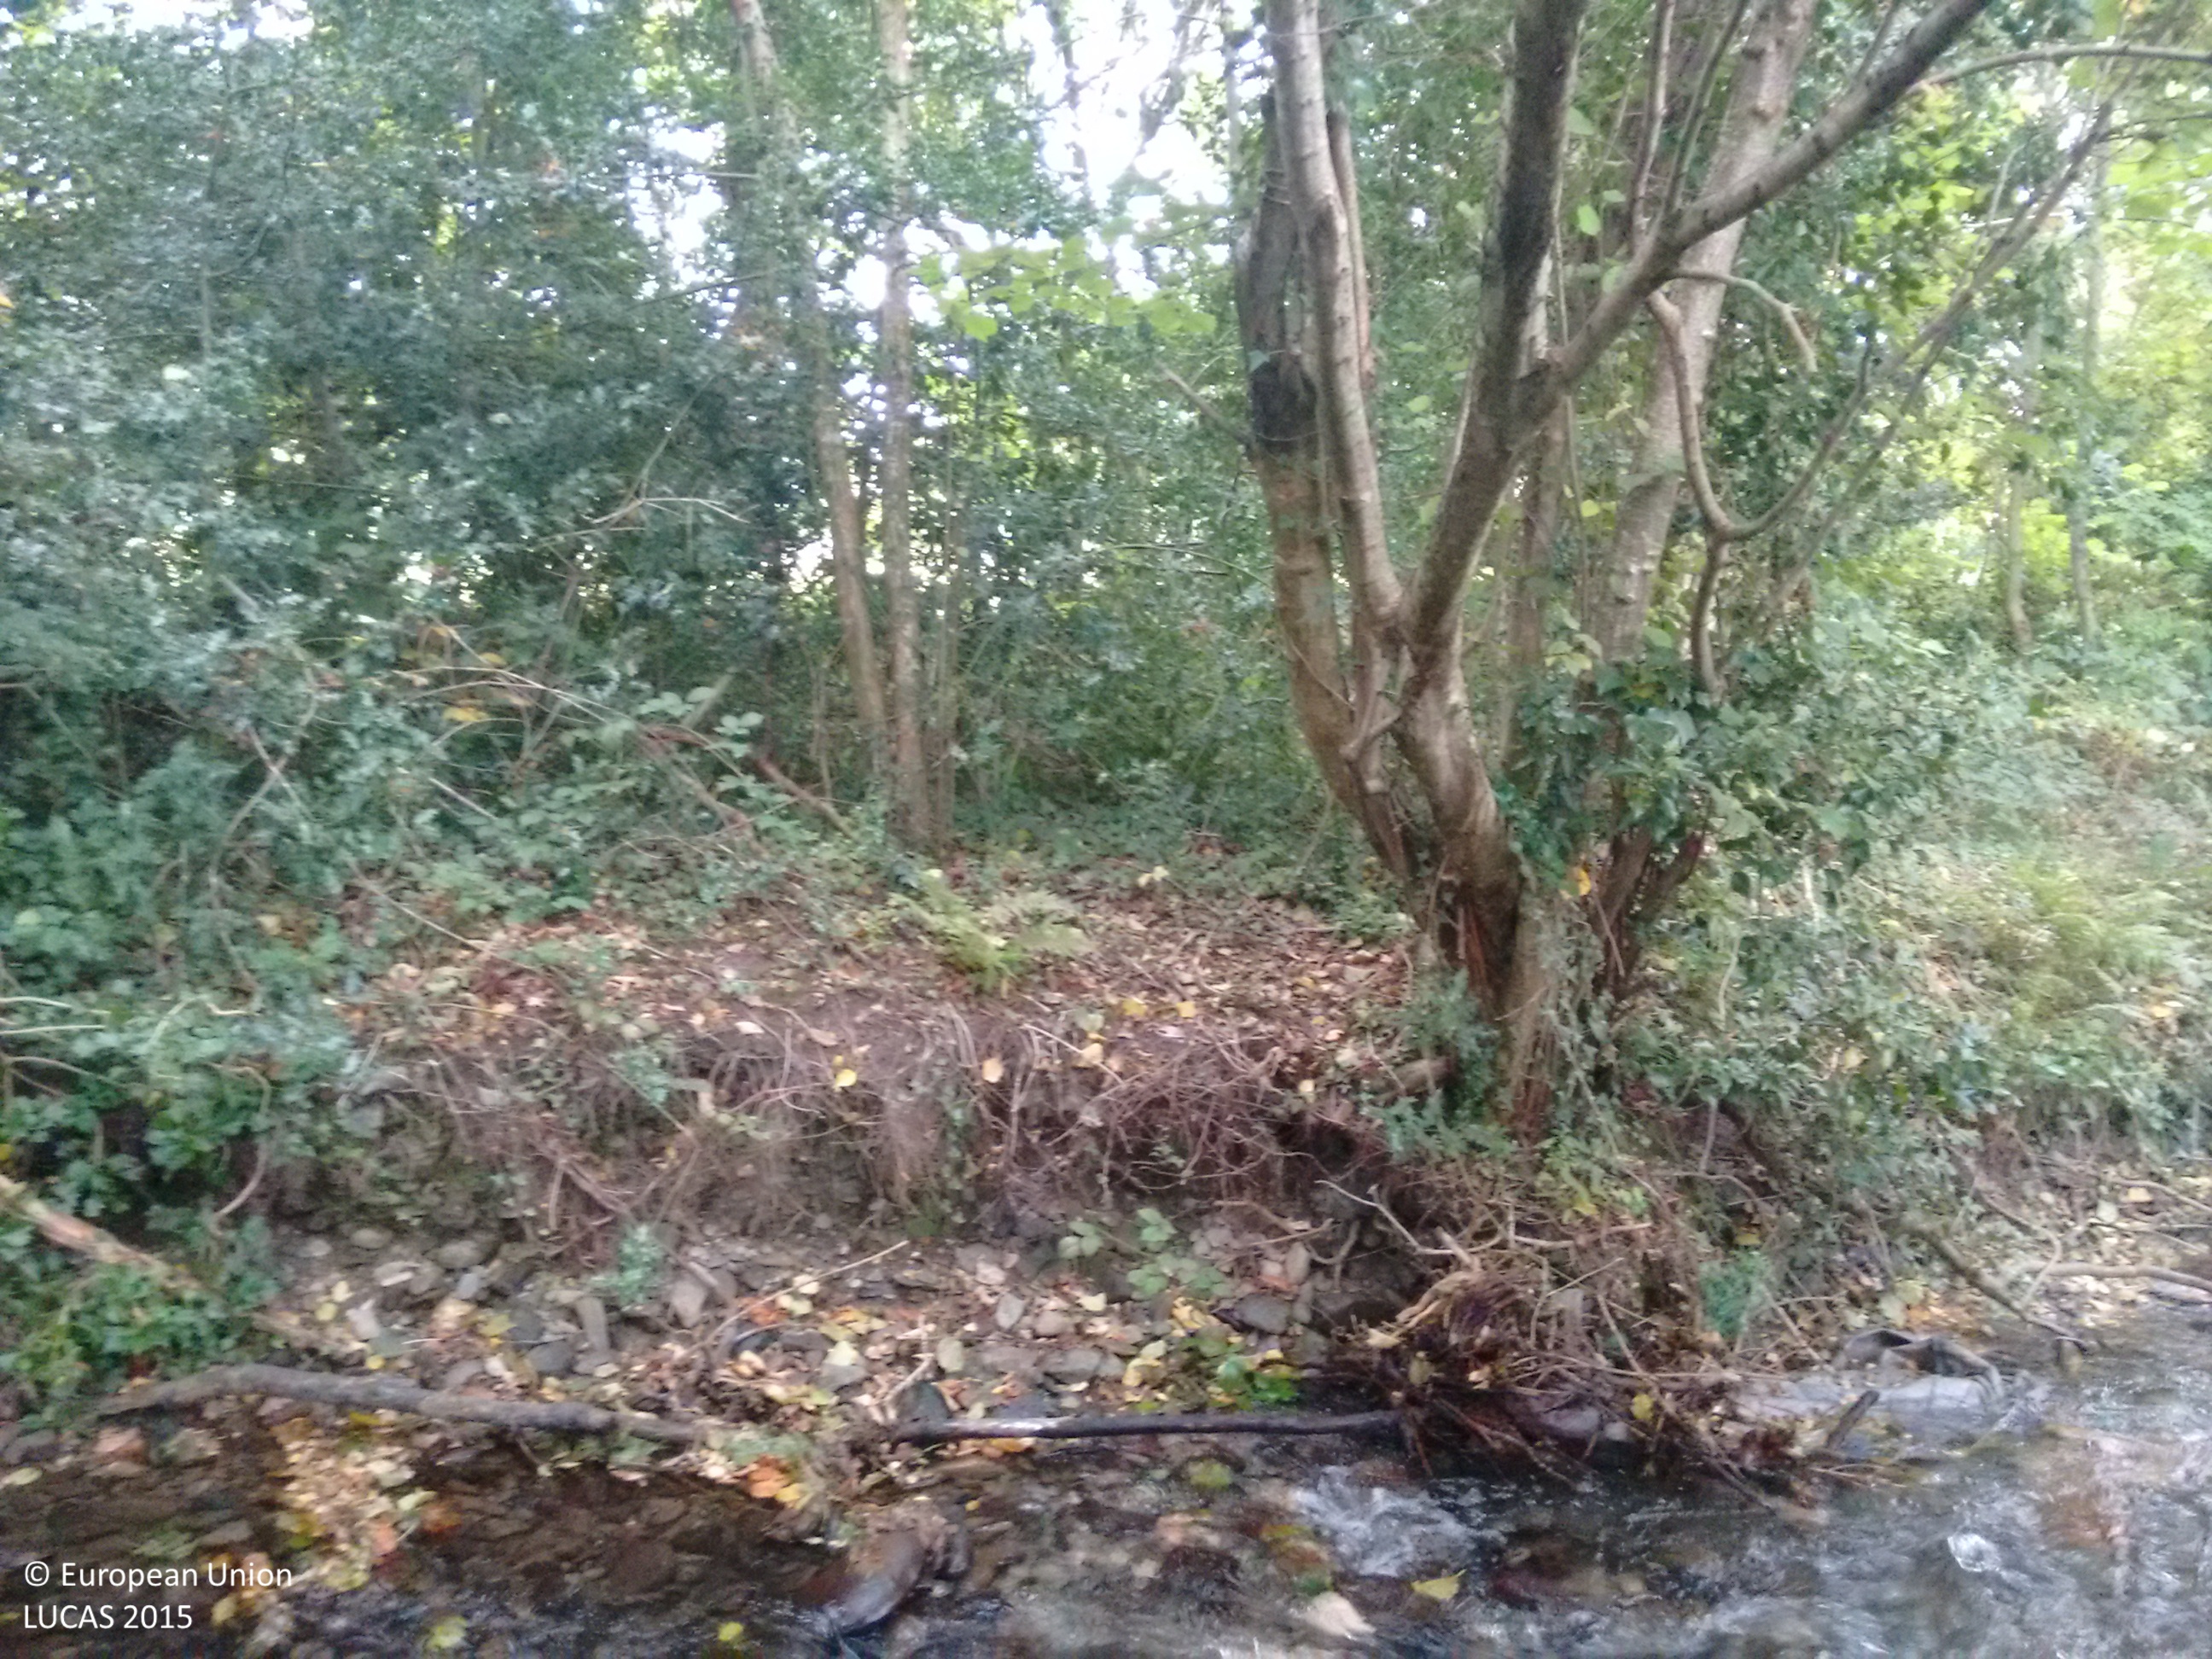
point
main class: Woodland
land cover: Broadleaved woodland
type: mesophytic deciduous forest
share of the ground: > 75 %
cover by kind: broadleaved forest trees 100 %
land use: Semi-natural and natural areas not in use
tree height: > 5 m
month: October
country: GB
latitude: 52.4376
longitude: -3.9953
